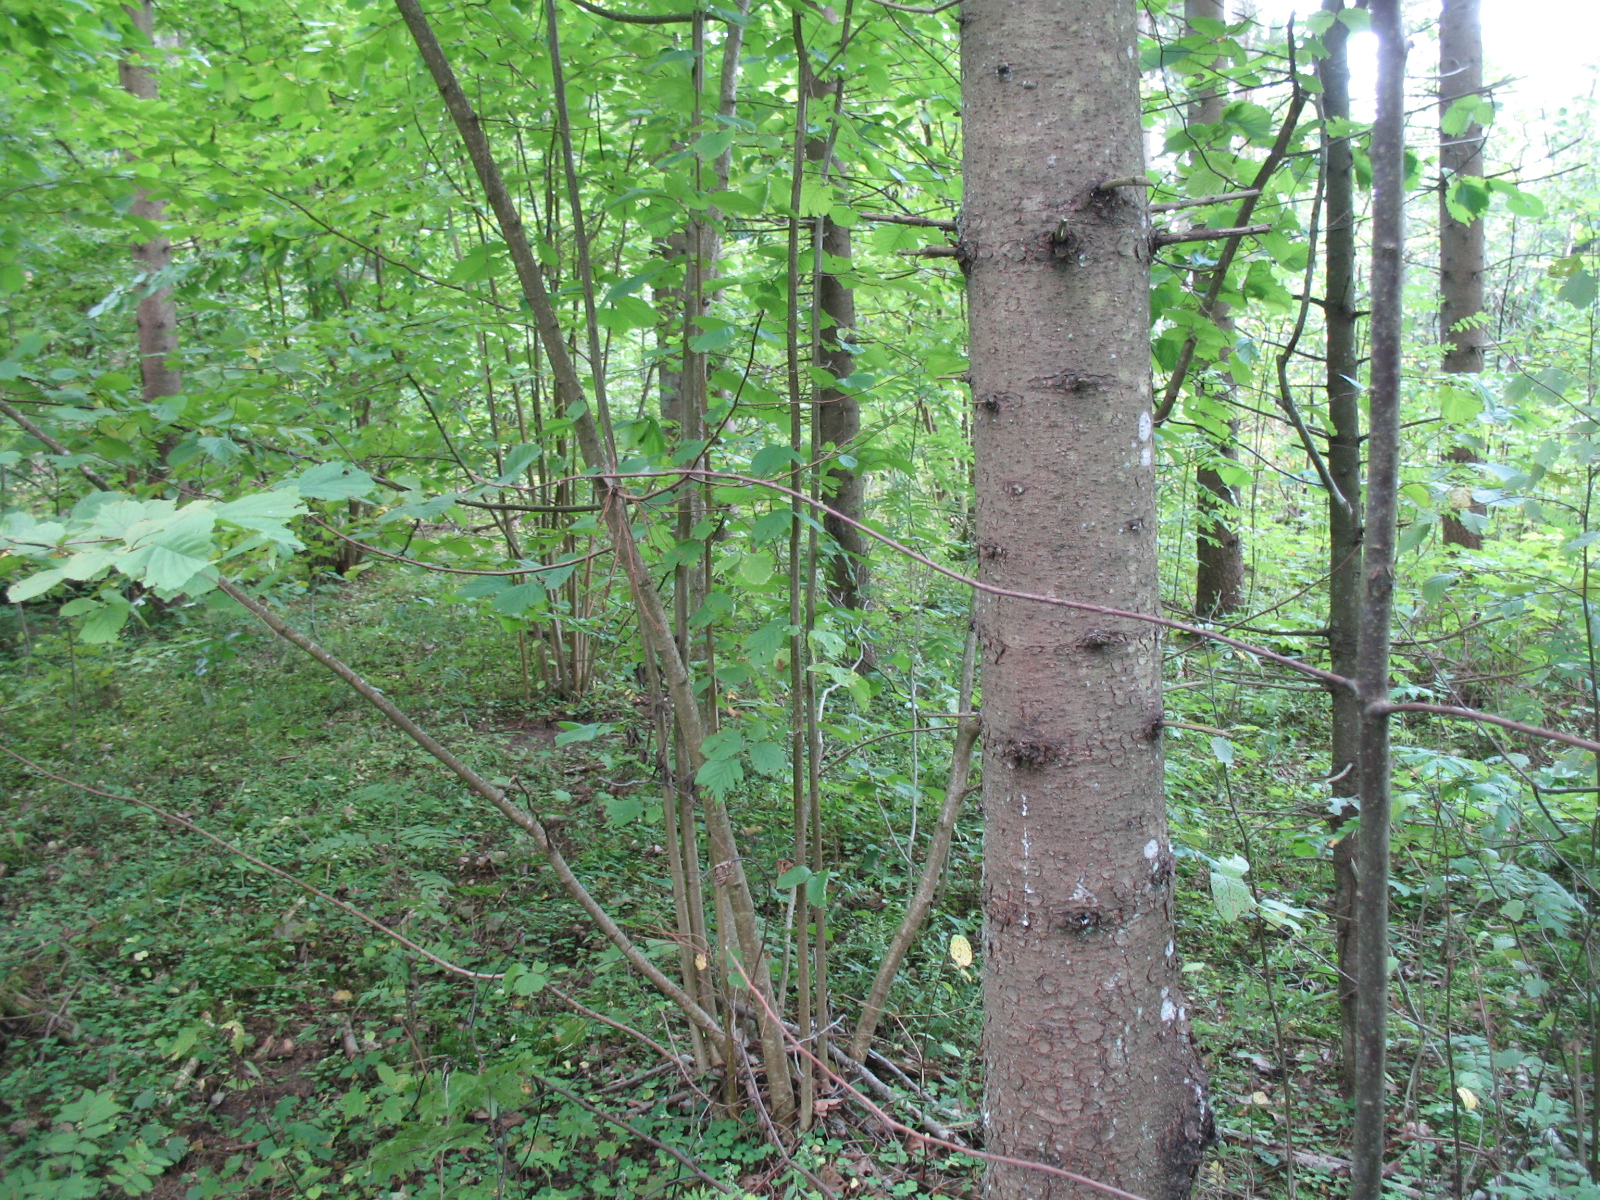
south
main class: Woodland
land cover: Spruce dominated mixed woodland
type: hemiboreal forest and nemoral coniferous forest and mixed broadleaved-coniferous forest
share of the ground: 50 - 75 %
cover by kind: coniferous forest trees 45 %, herbaceous plants 30 %, broadleaved forest trees 15 %, shrubs 10 %
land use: Forestry
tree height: > 5 m
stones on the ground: < 10 %
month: September
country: LV
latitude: 56.2095
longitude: 25.9493
